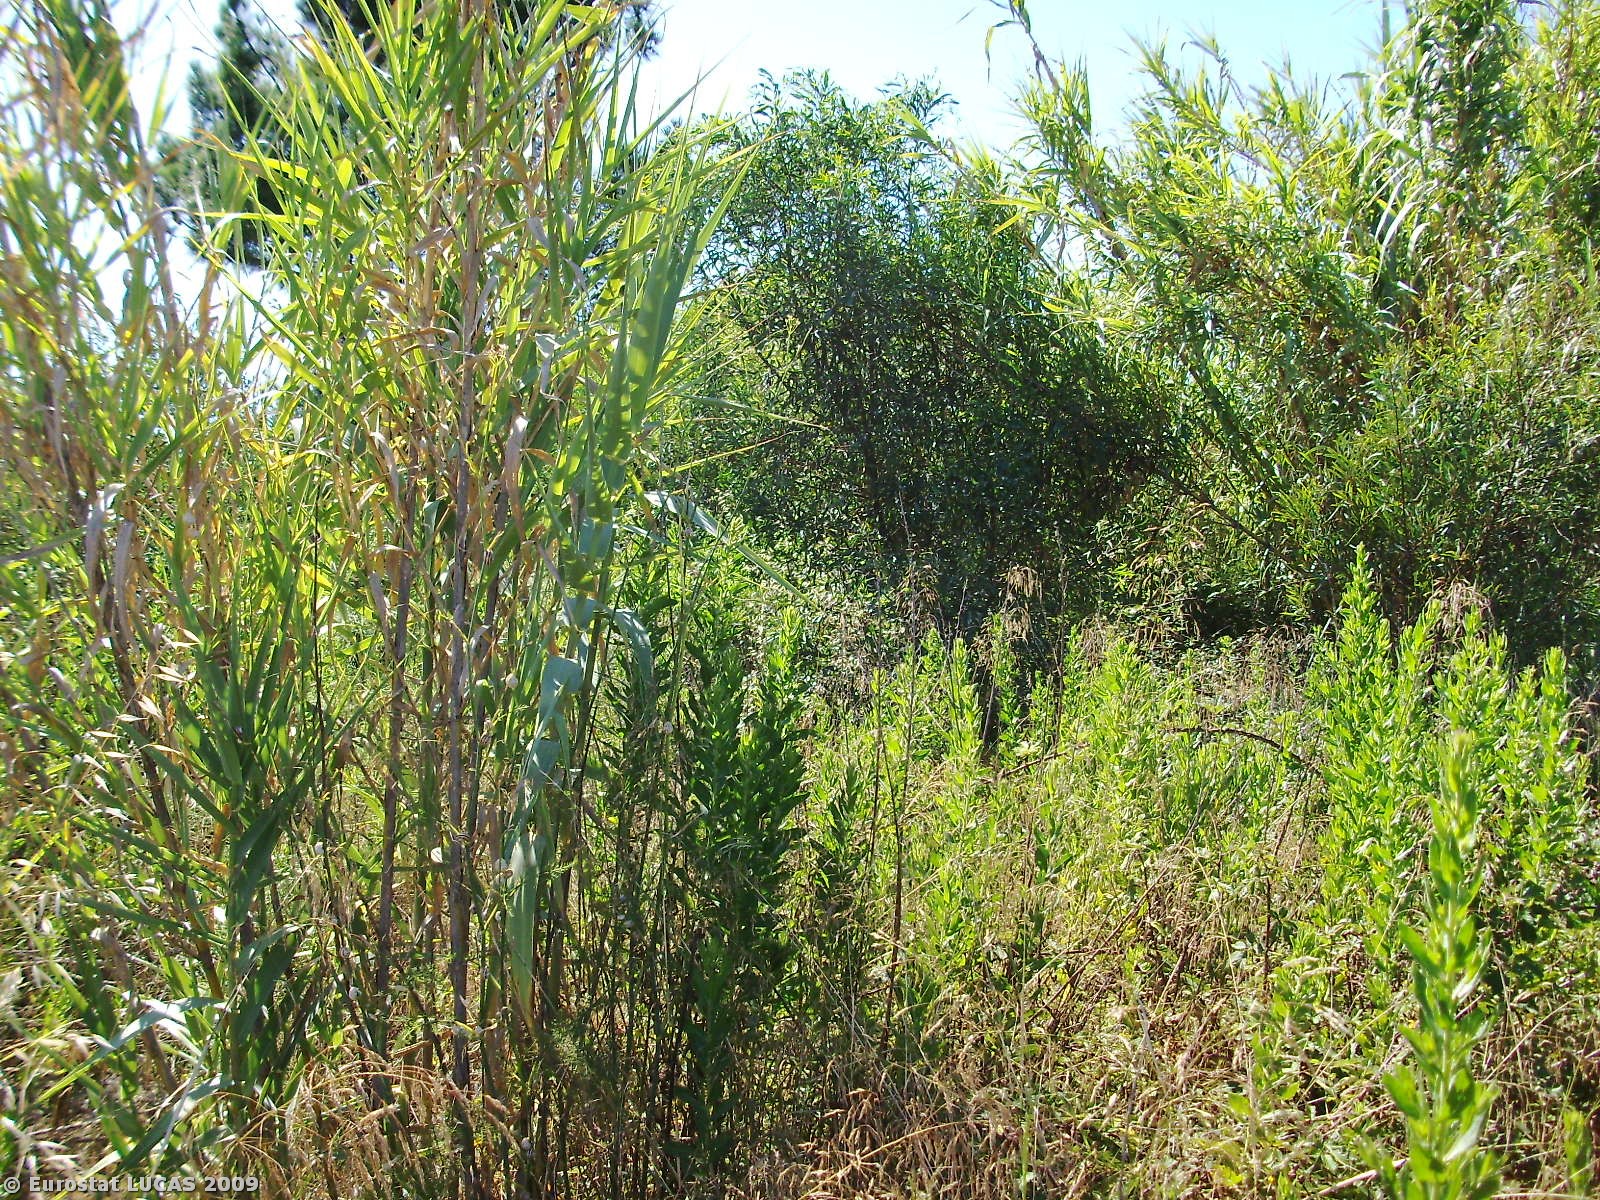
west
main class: Shrubland
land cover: Shrubland with sparse tree cover
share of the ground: > 75 %
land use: Telecommunication
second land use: Fallow land
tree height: > 5 m
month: July
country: PT
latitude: 39.6680
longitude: -8.9136
